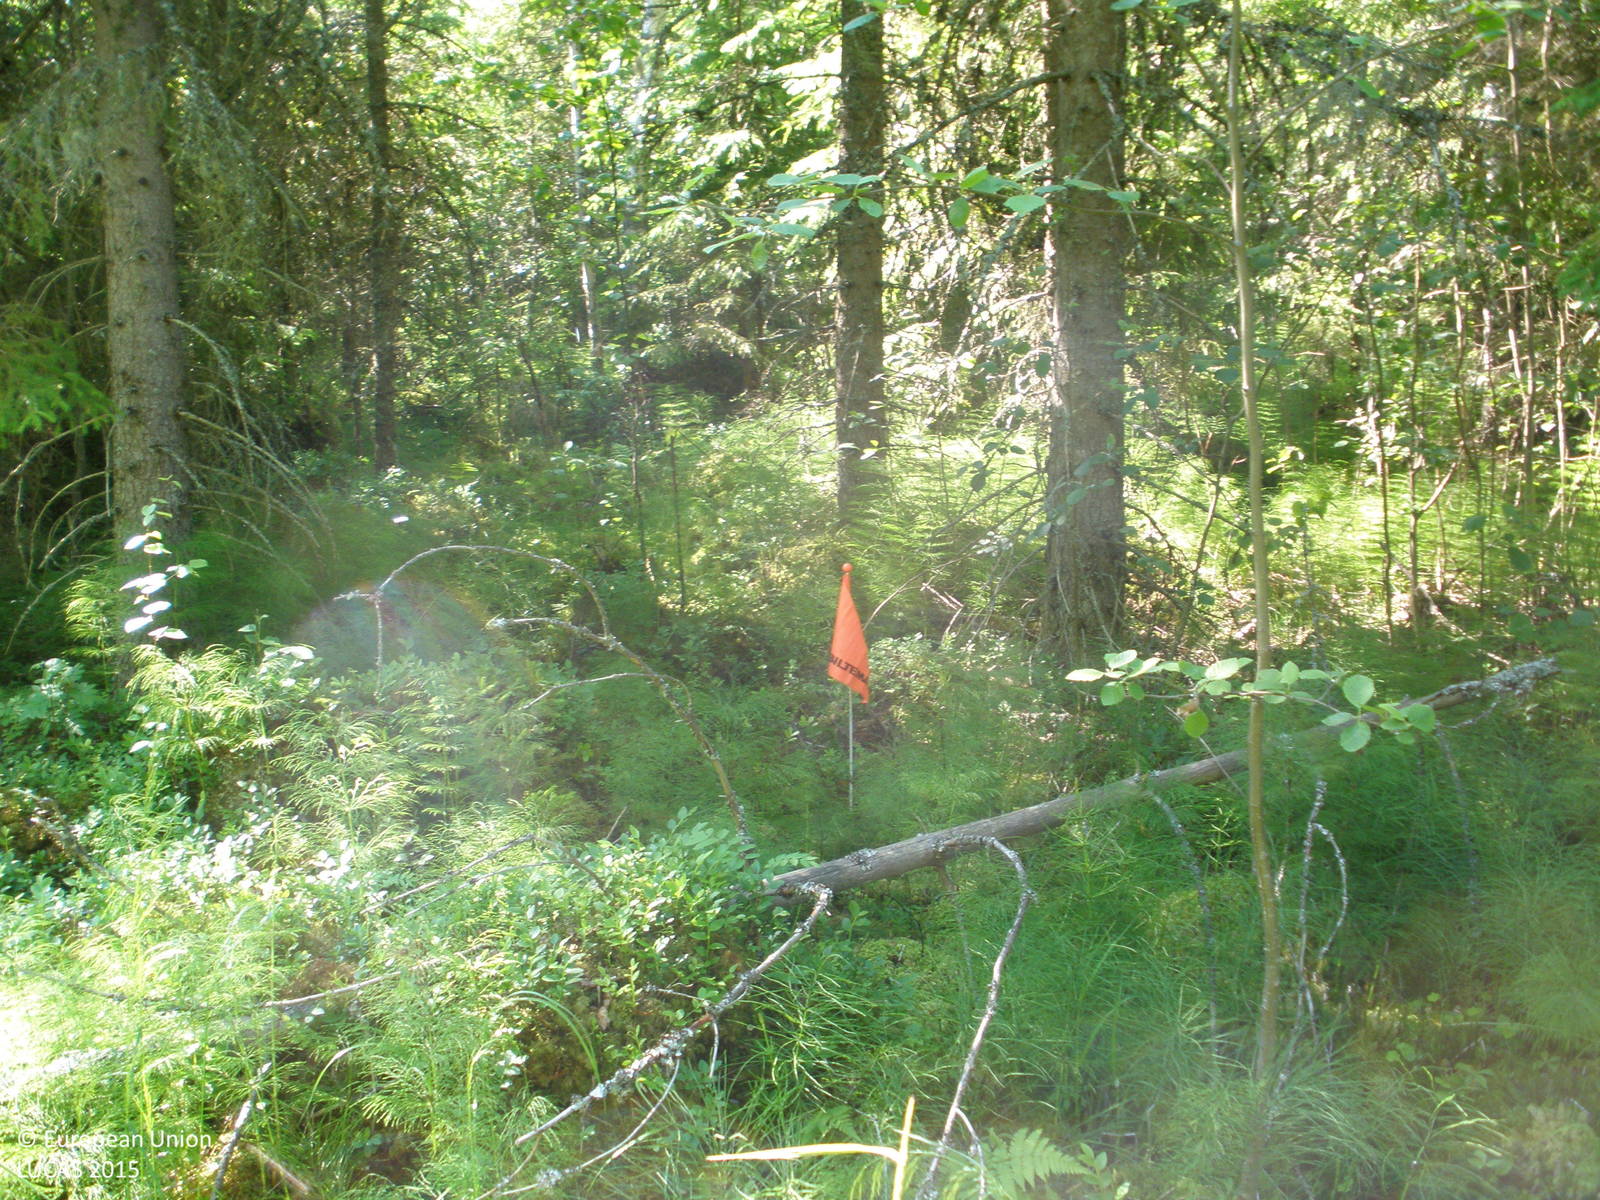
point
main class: Woodland
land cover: Spruce dominated mixed woodland
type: boreal forest
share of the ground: > 75 %
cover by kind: coniferous forest trees 60 %, broadleaved forest trees 25 %, shrubs 5 %, herbaceous plants 5 %, lichens and mosses 5 %
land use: Forestry
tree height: > 5 m
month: July
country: FI
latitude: 61.0999
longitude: 23.7200
